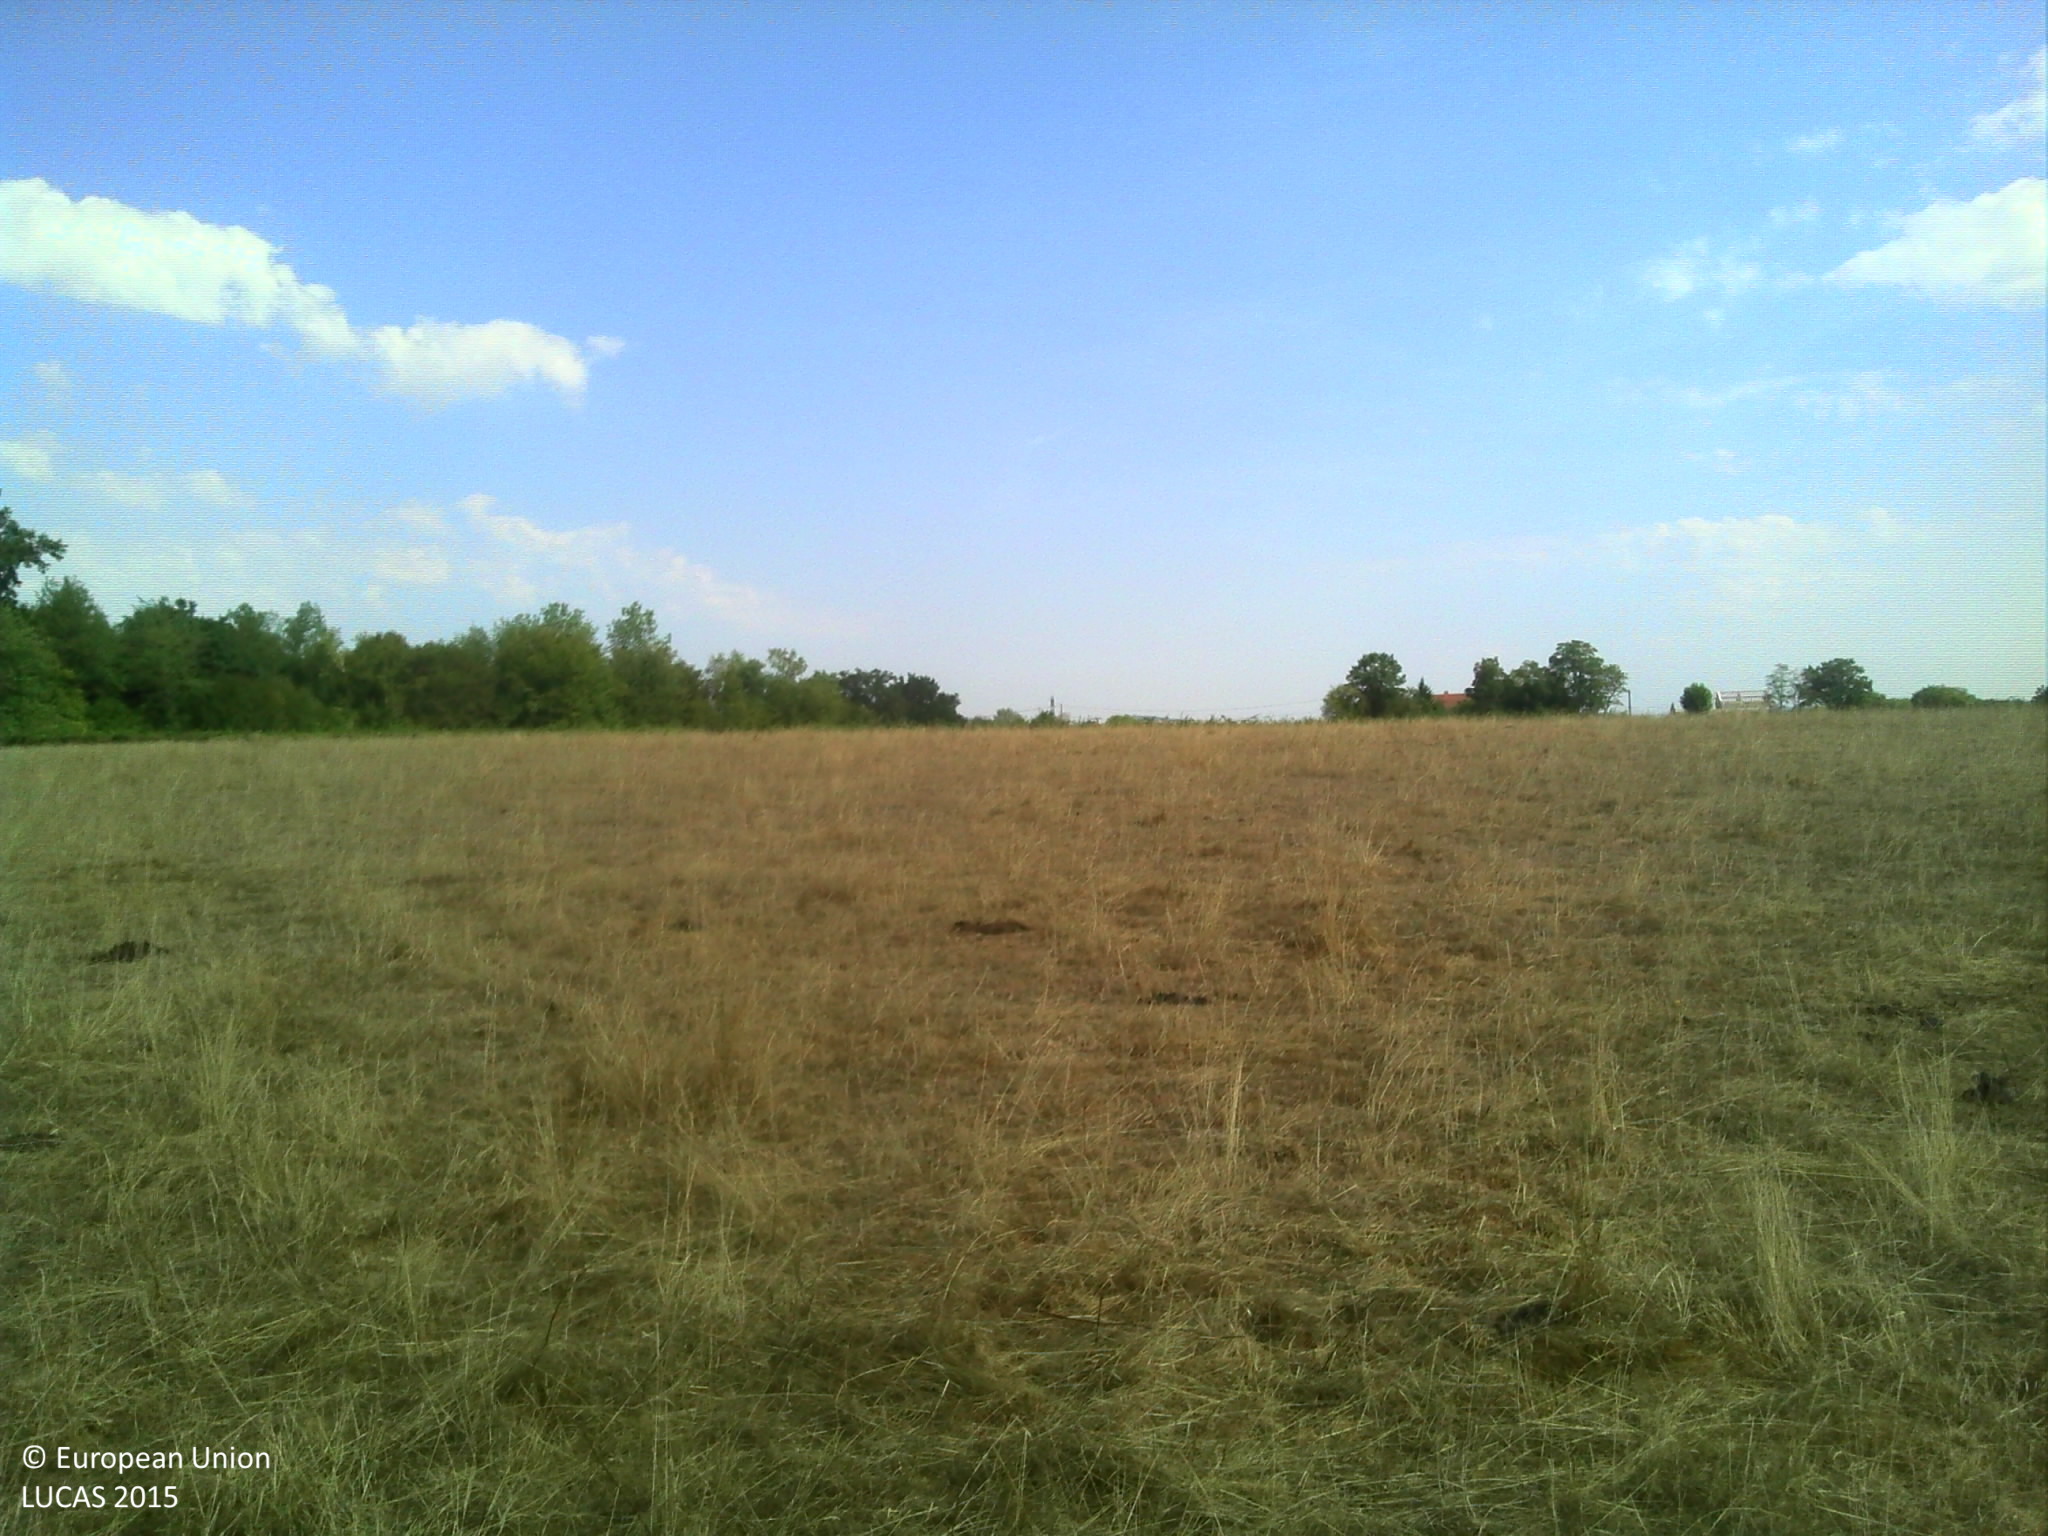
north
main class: Grassland
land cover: Grassland without tree/shrub cover
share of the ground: > 75 %
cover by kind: herbaceous plants 100 %
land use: Agriculture (excluding fallow land and kitchen gardens)
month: August
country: FR
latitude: 46.7287
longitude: 4.4132
